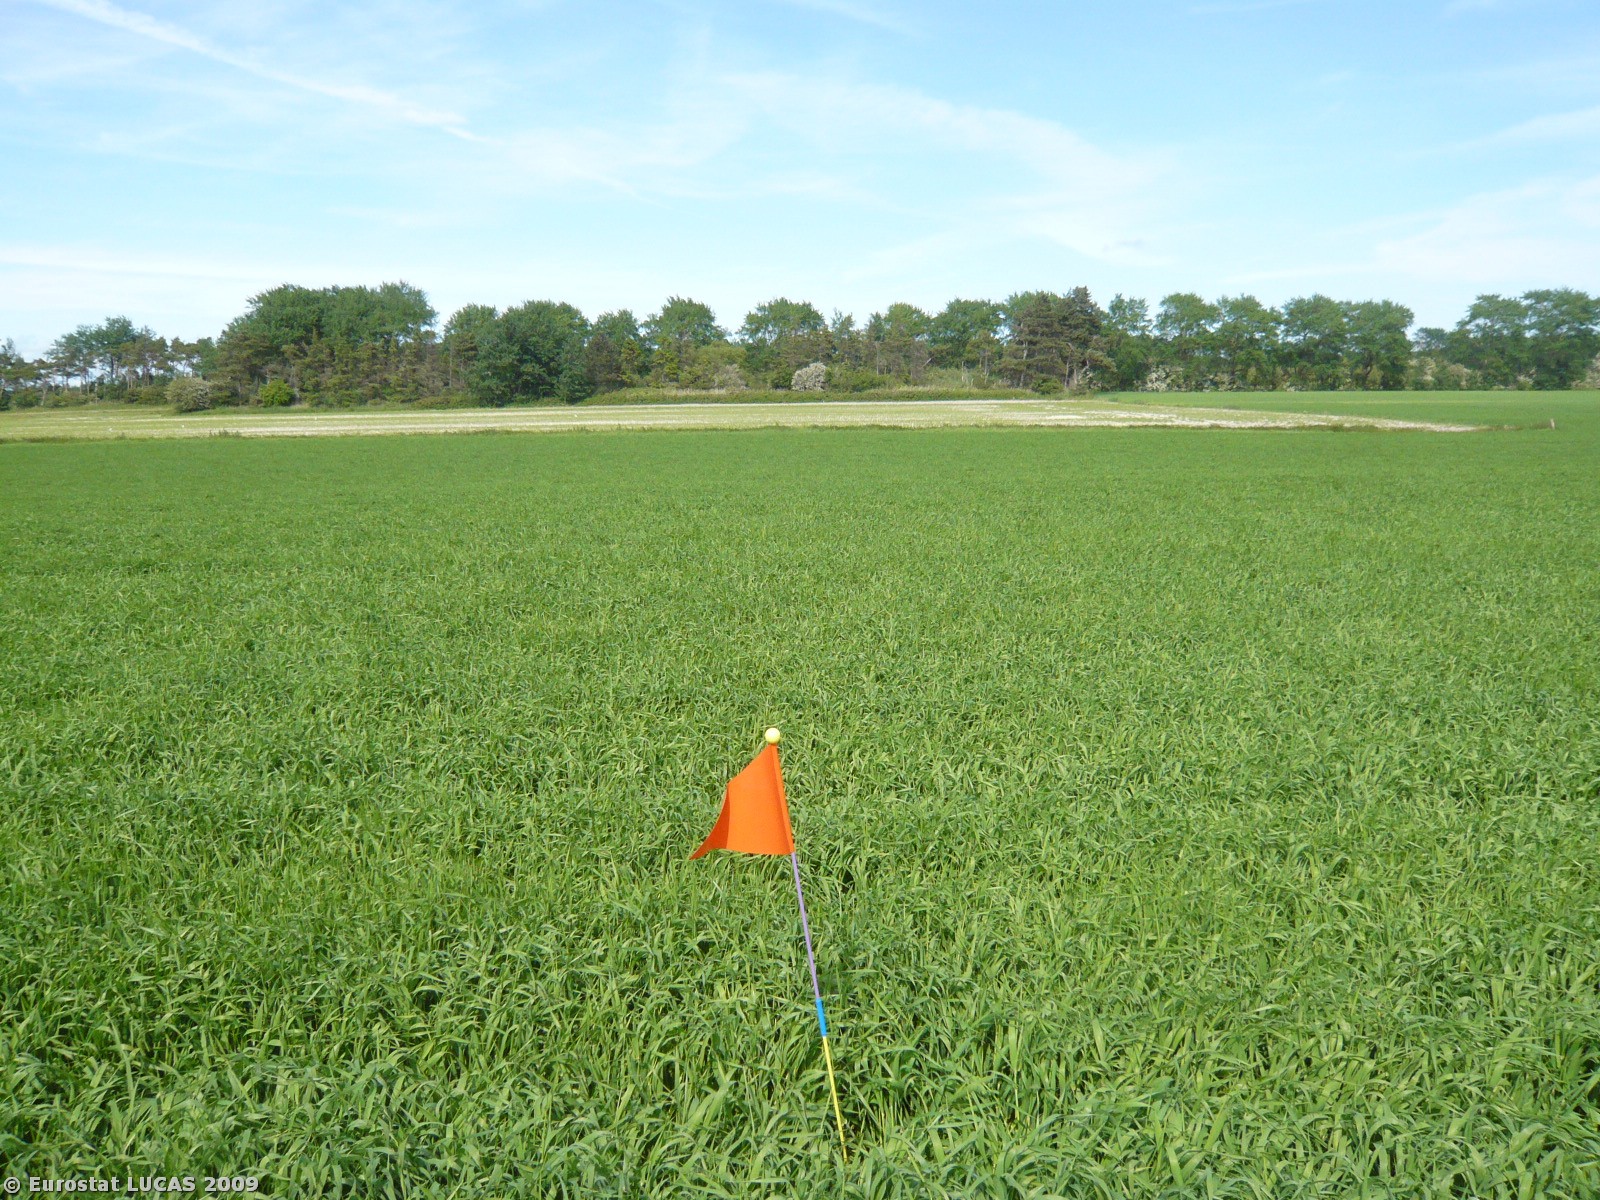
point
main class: Cropland
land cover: Barley
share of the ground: > 75 %
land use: Agriculture (excluding fallow land and kitchen gardens)
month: June
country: DK
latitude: 54.6090
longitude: 11.9342
